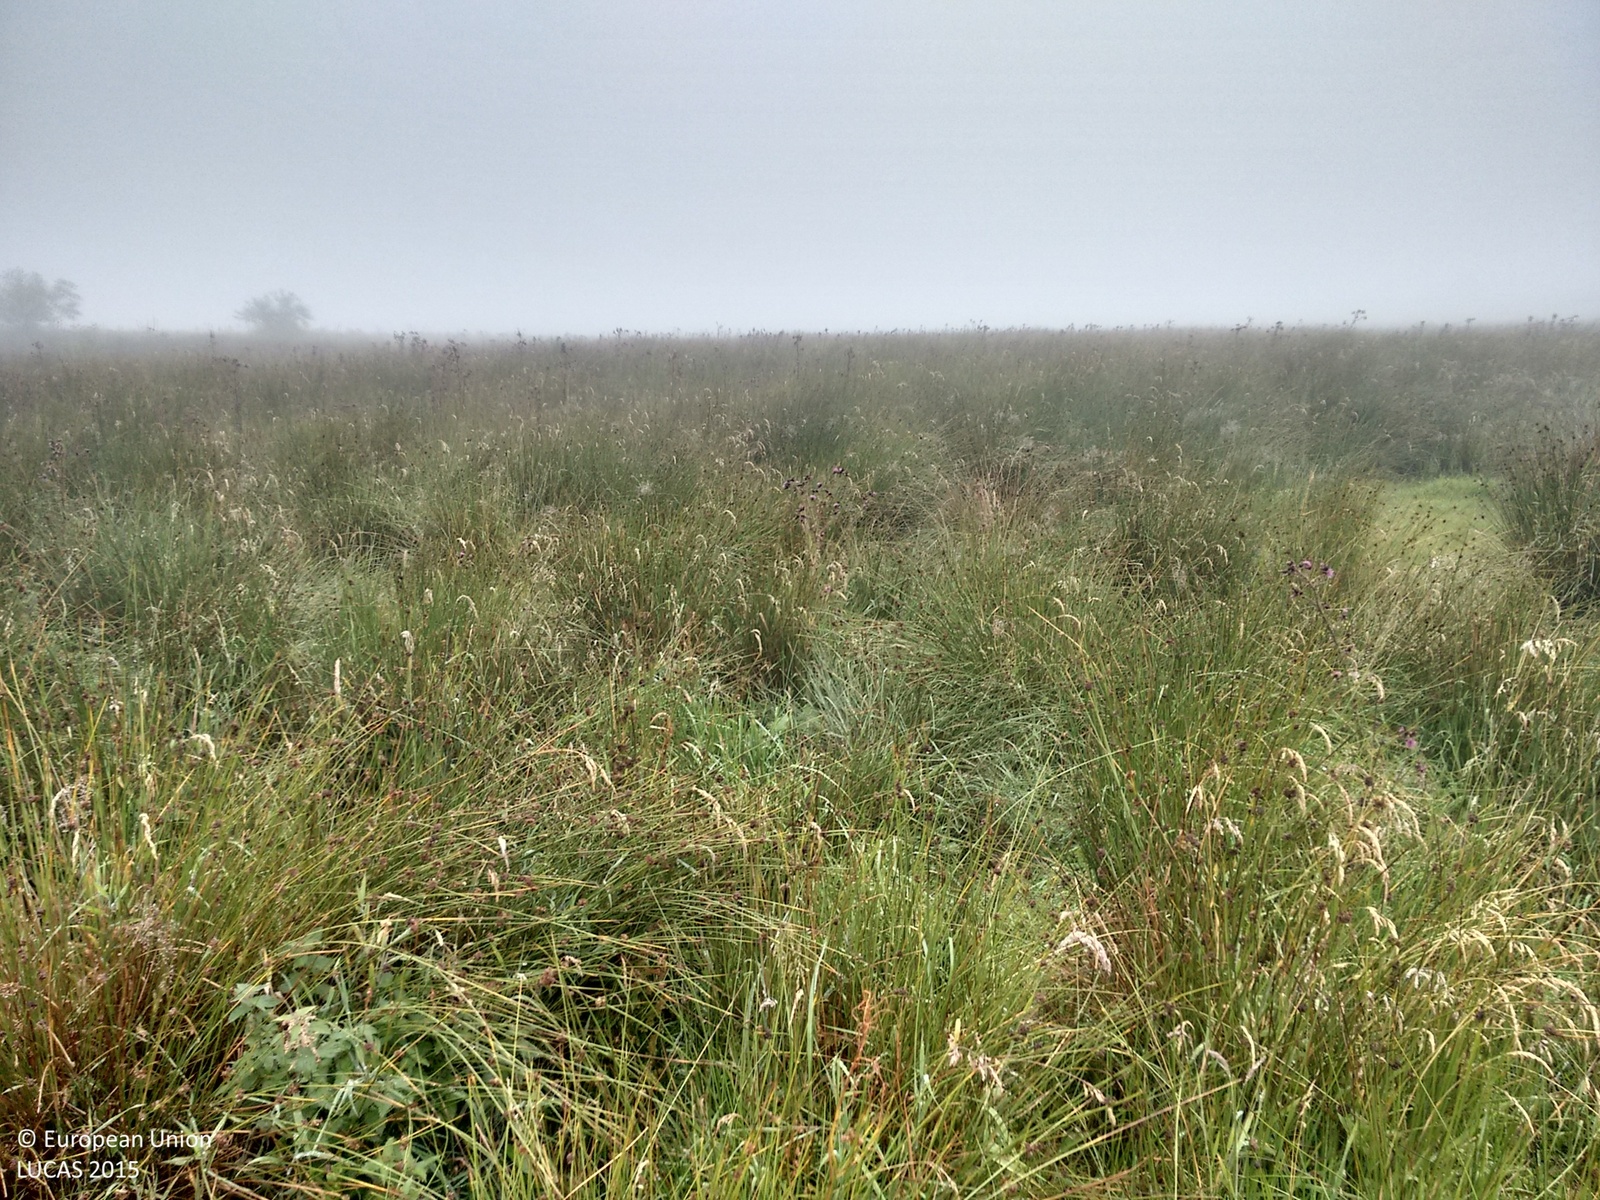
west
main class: Grassland
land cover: Grassland without tree/shrub cover
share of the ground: > 75 %
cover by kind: herbaceous plants 100 %
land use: Agriculture (excluding fallow land and kitchen gardens)
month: August
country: GB
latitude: 50.5567
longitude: -3.9972
